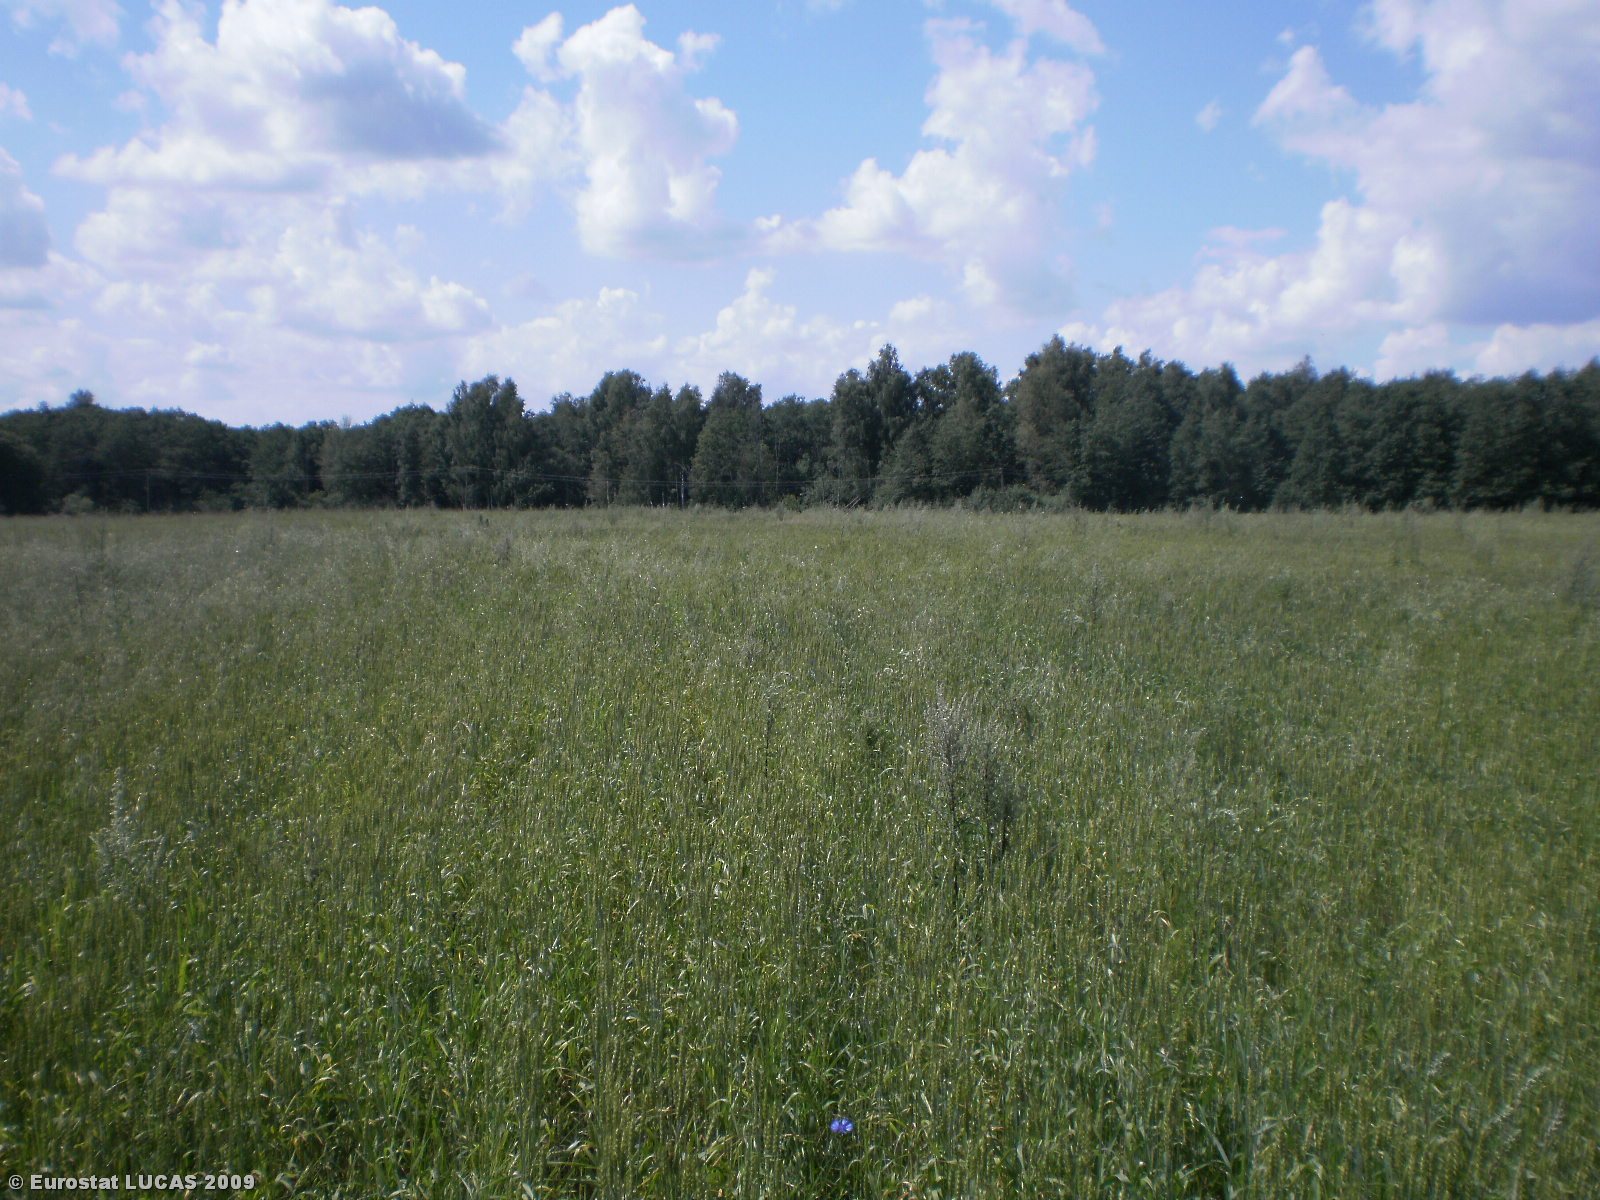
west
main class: Cropland
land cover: Common wheat
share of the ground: > 75 %
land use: Agriculture (excluding fallow land and kitchen gardens)
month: July
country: LT
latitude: 56.1811
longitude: 24.9783
